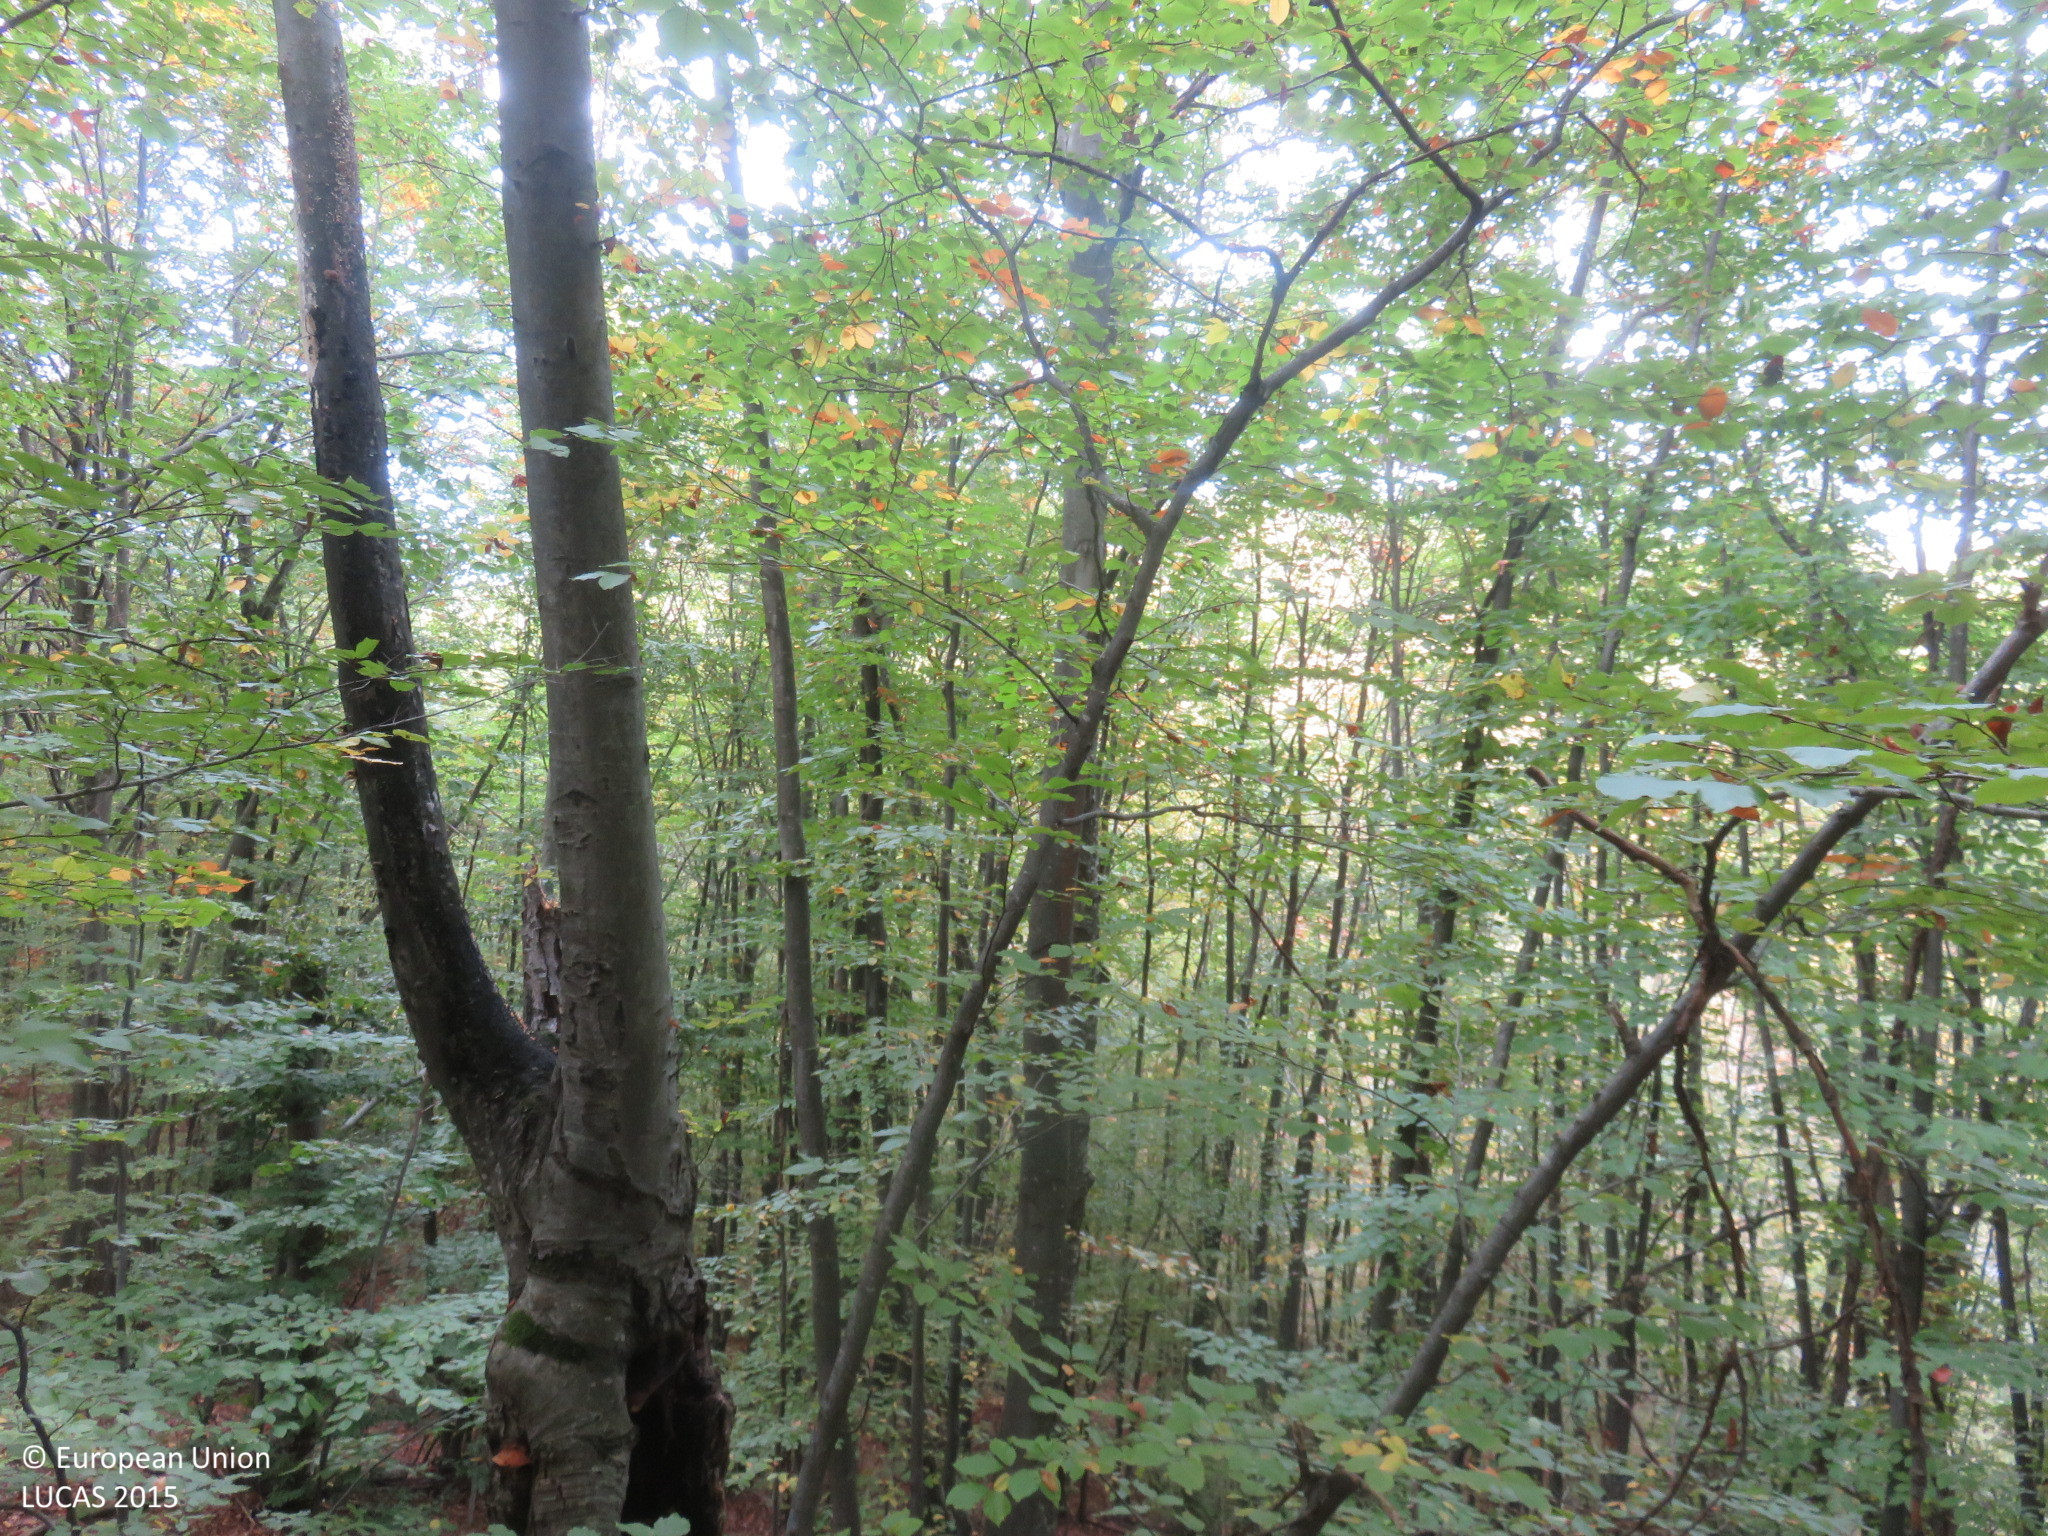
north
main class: Woodland
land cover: Broadleaved woodland
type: beech forest
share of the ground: > 75 %
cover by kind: broadleaved forest trees 85 %, unconsolidated bare surface 10 %, shrubs 5 %
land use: Forestry
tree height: > 5 m
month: October
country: BG
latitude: 42.9090
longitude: 24.9709
